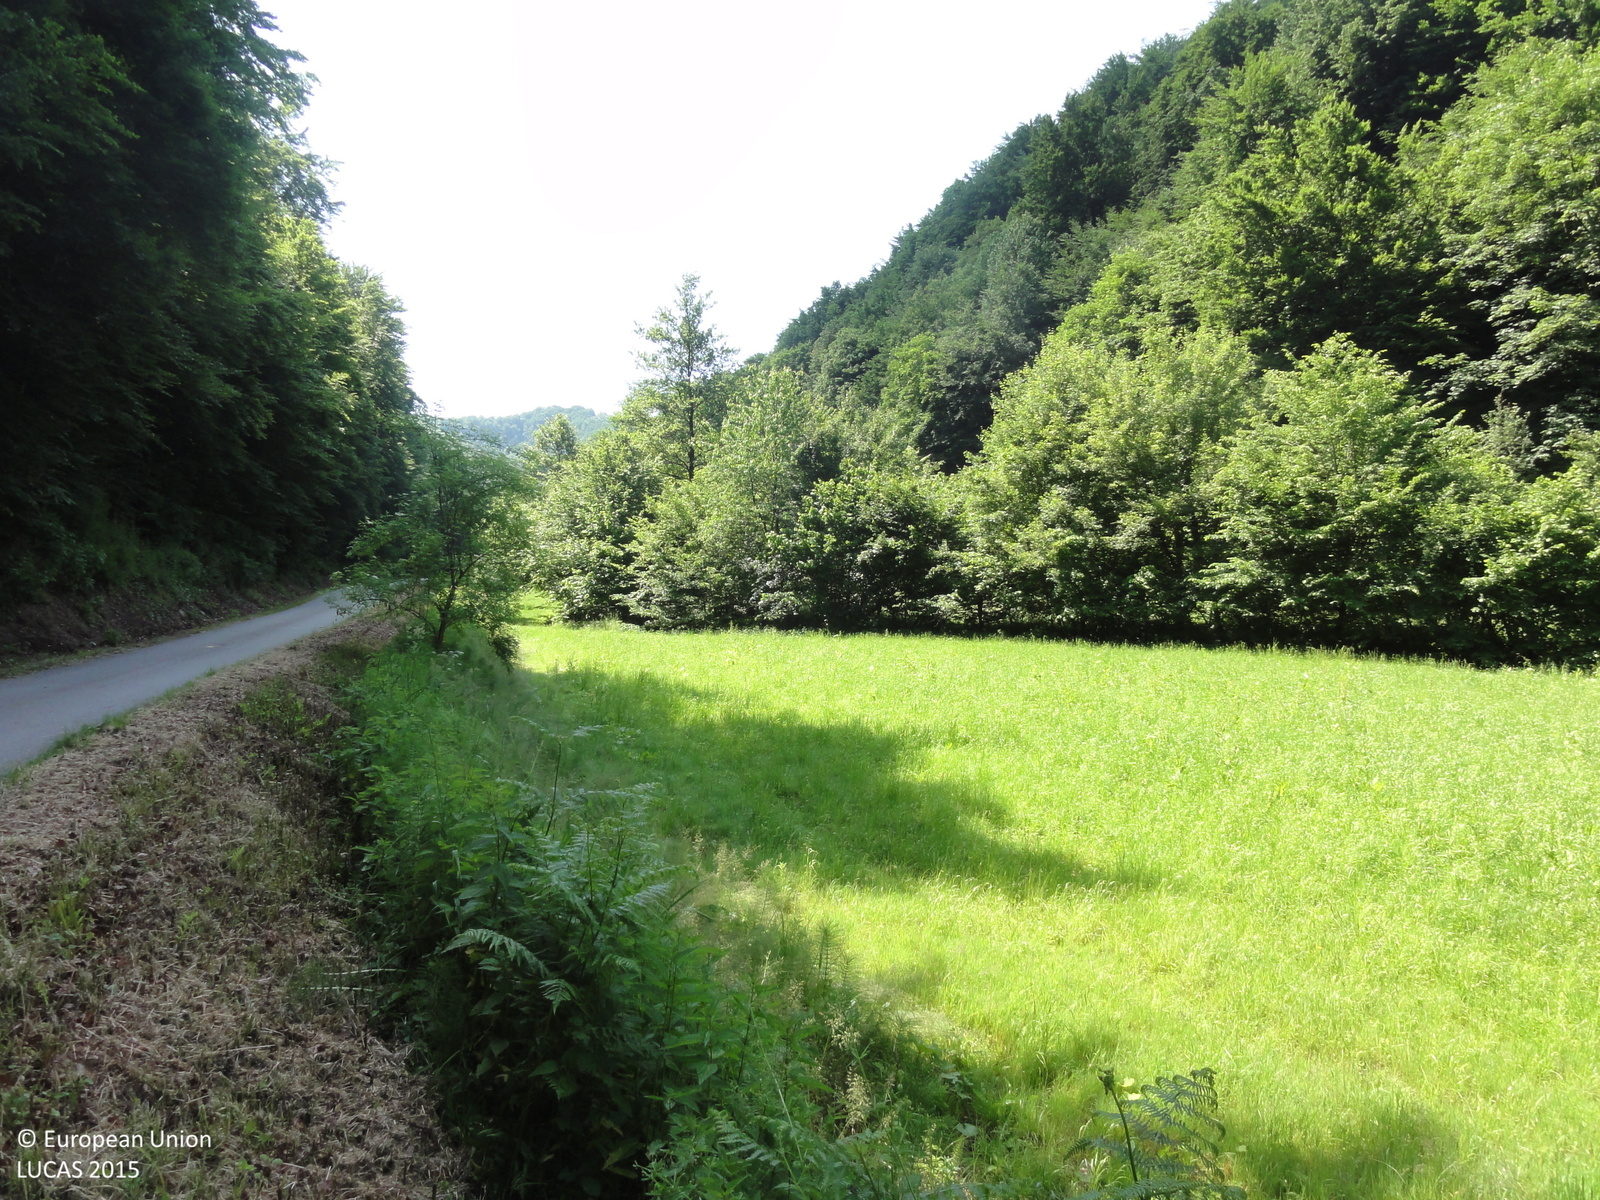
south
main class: Grassland
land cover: Spontaneously vegetated surfaces
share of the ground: > 75 %
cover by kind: herbaceous plants 95 %, shrubs 5 %
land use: Semi-natural and natural areas not in use
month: June
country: SI
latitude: 46.3394
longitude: 15.7803
